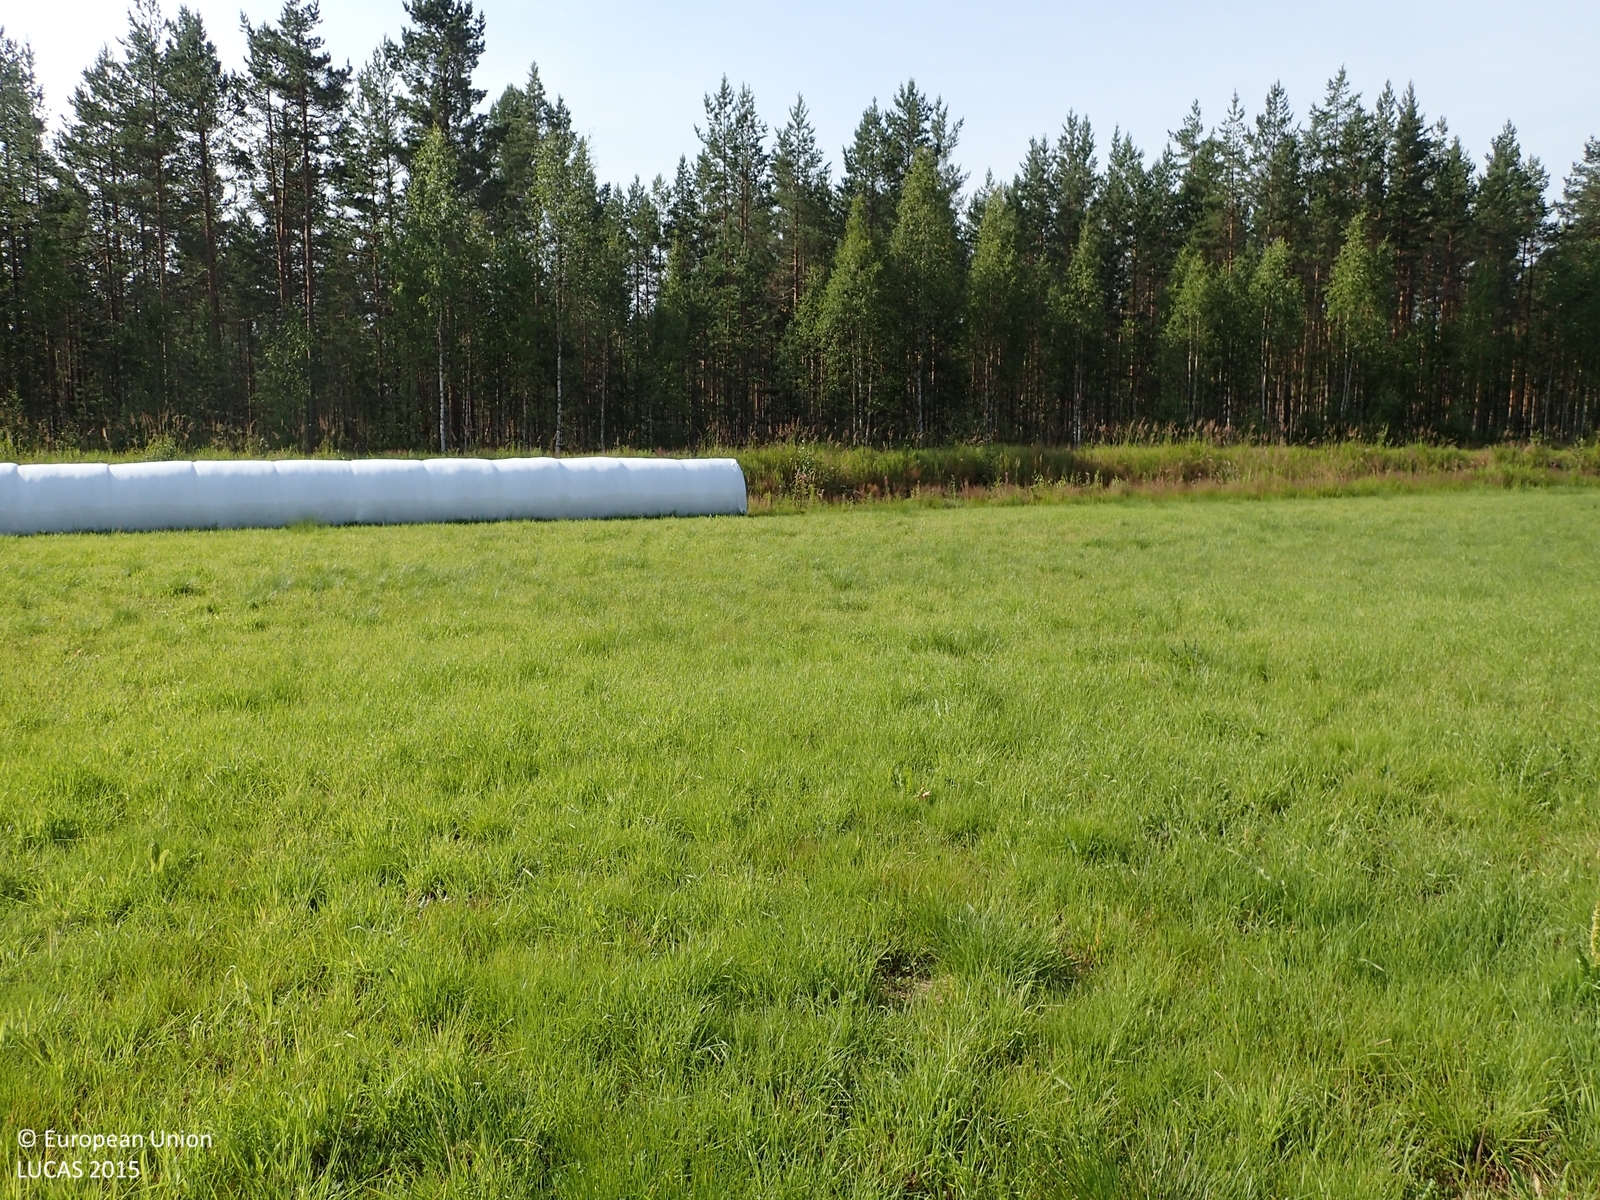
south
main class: Cropland
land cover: Temporary grasslands
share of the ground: > 75 %
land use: Agriculture (excluding fallow land and kitchen gardens)
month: August
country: FI
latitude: 62.5857
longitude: 22.0219
